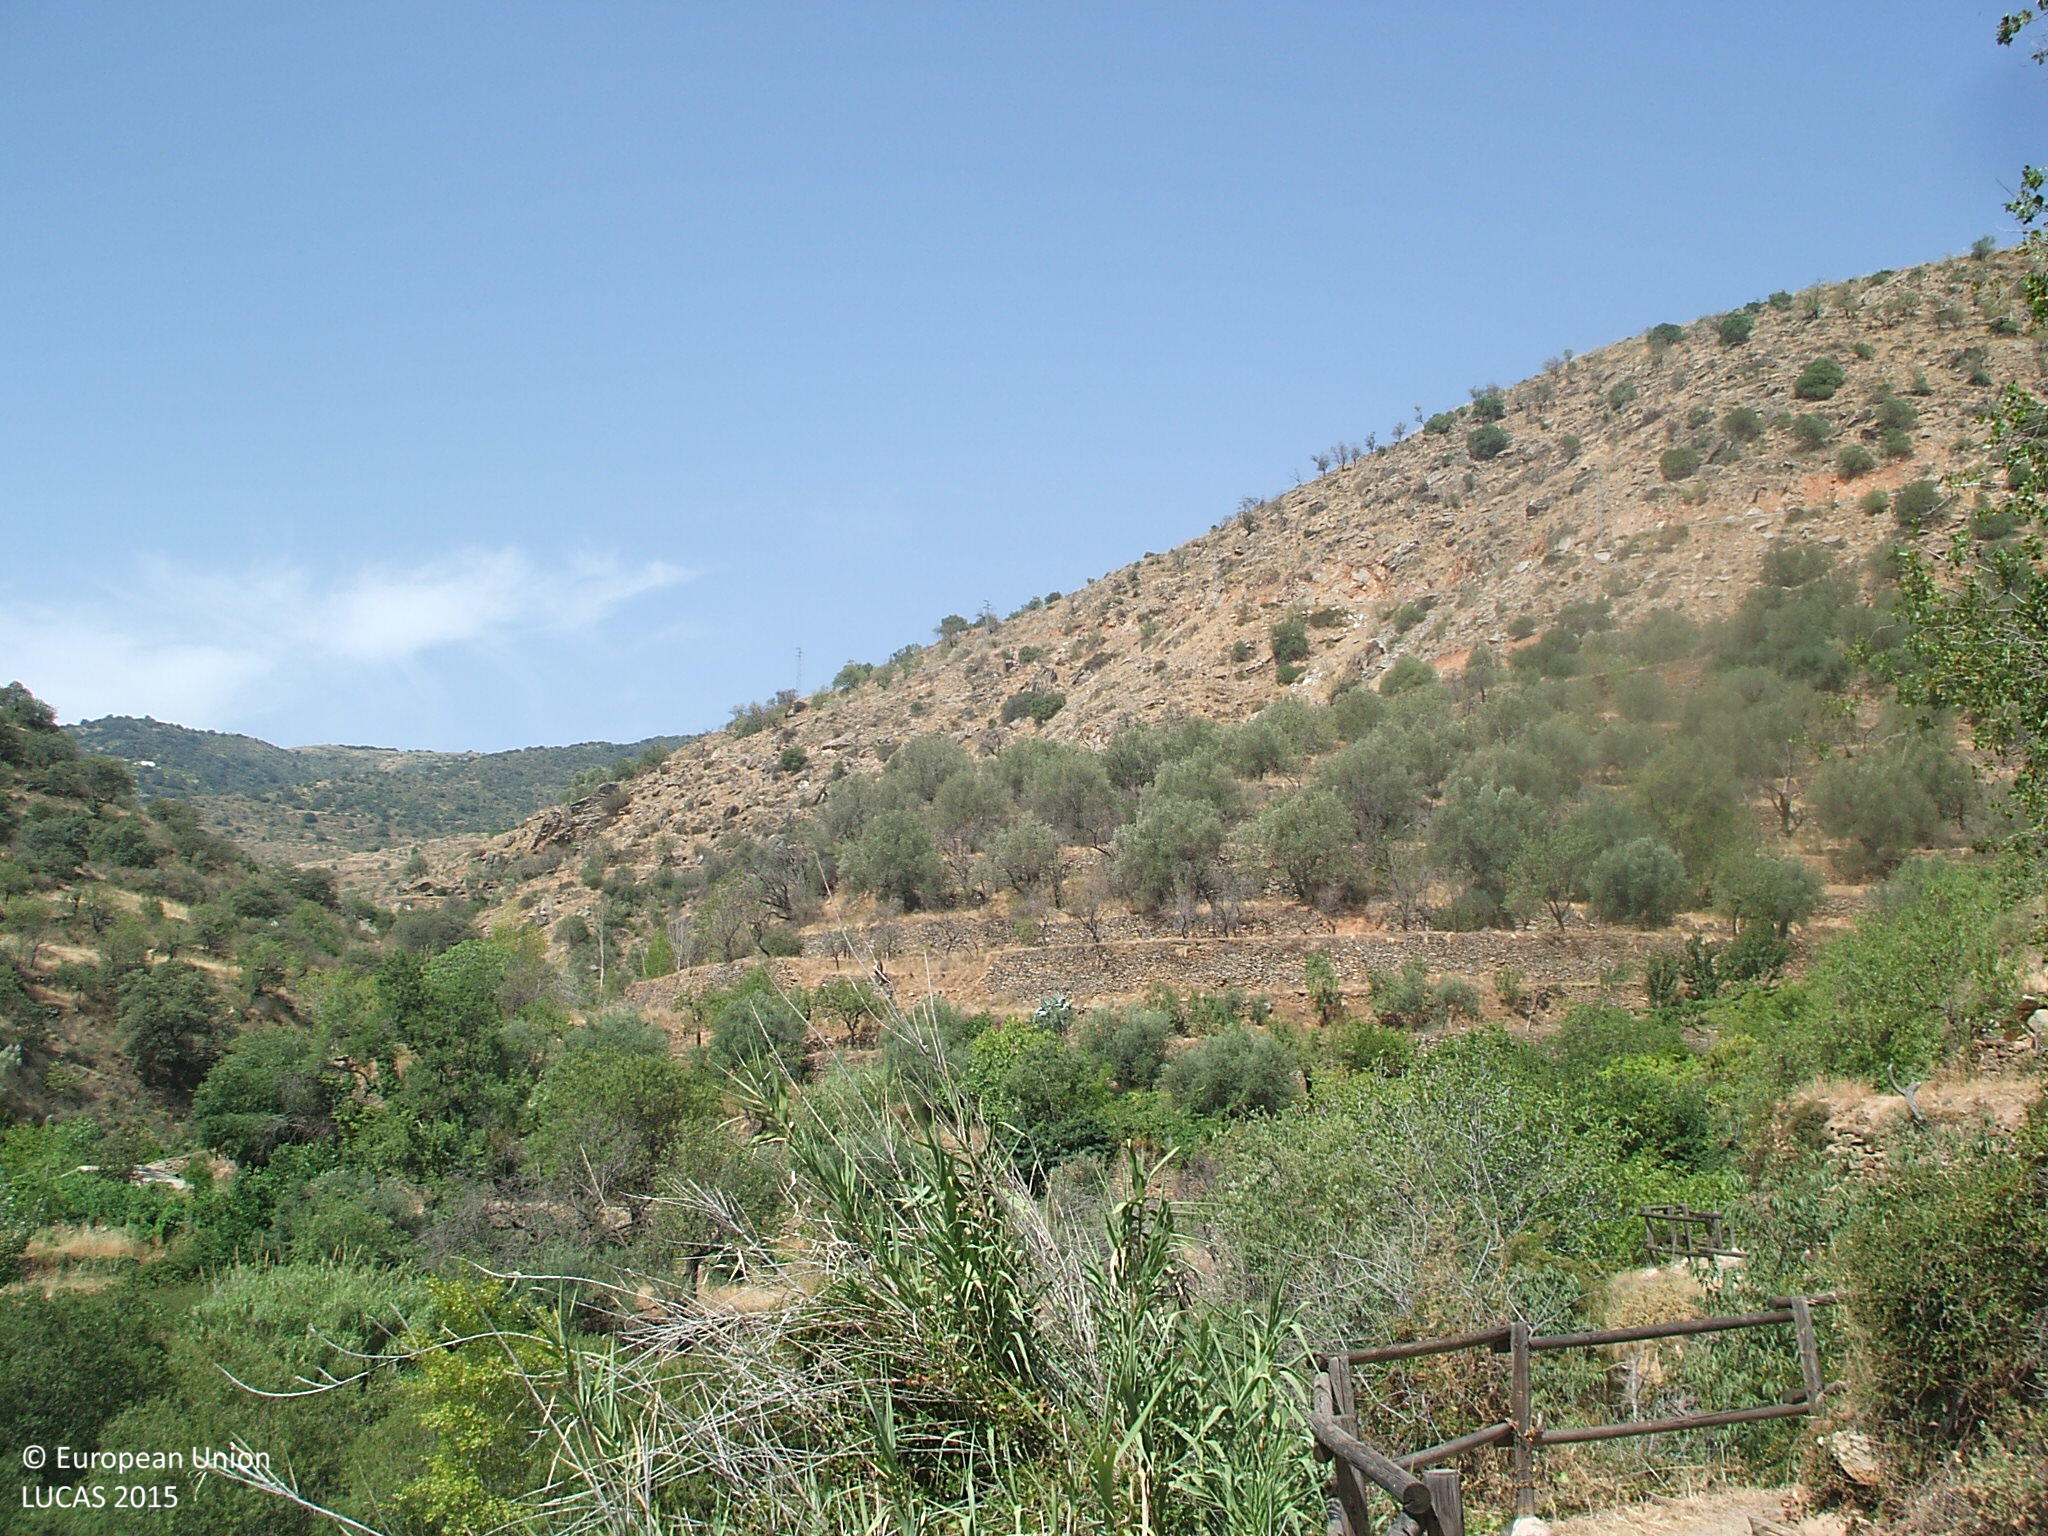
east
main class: Woodland
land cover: Broadleaved woodland
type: broadleaved evergreen forest
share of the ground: 10 - 25 %
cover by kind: herbaceous plants 70 %, broadleaved forest trees 15 %, shrubs 15 %
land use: Semi-natural and natural areas not in use
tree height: > 5 m
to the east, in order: Broadleaved woodland
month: July
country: ES
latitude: 37.2897
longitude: -2.3326
